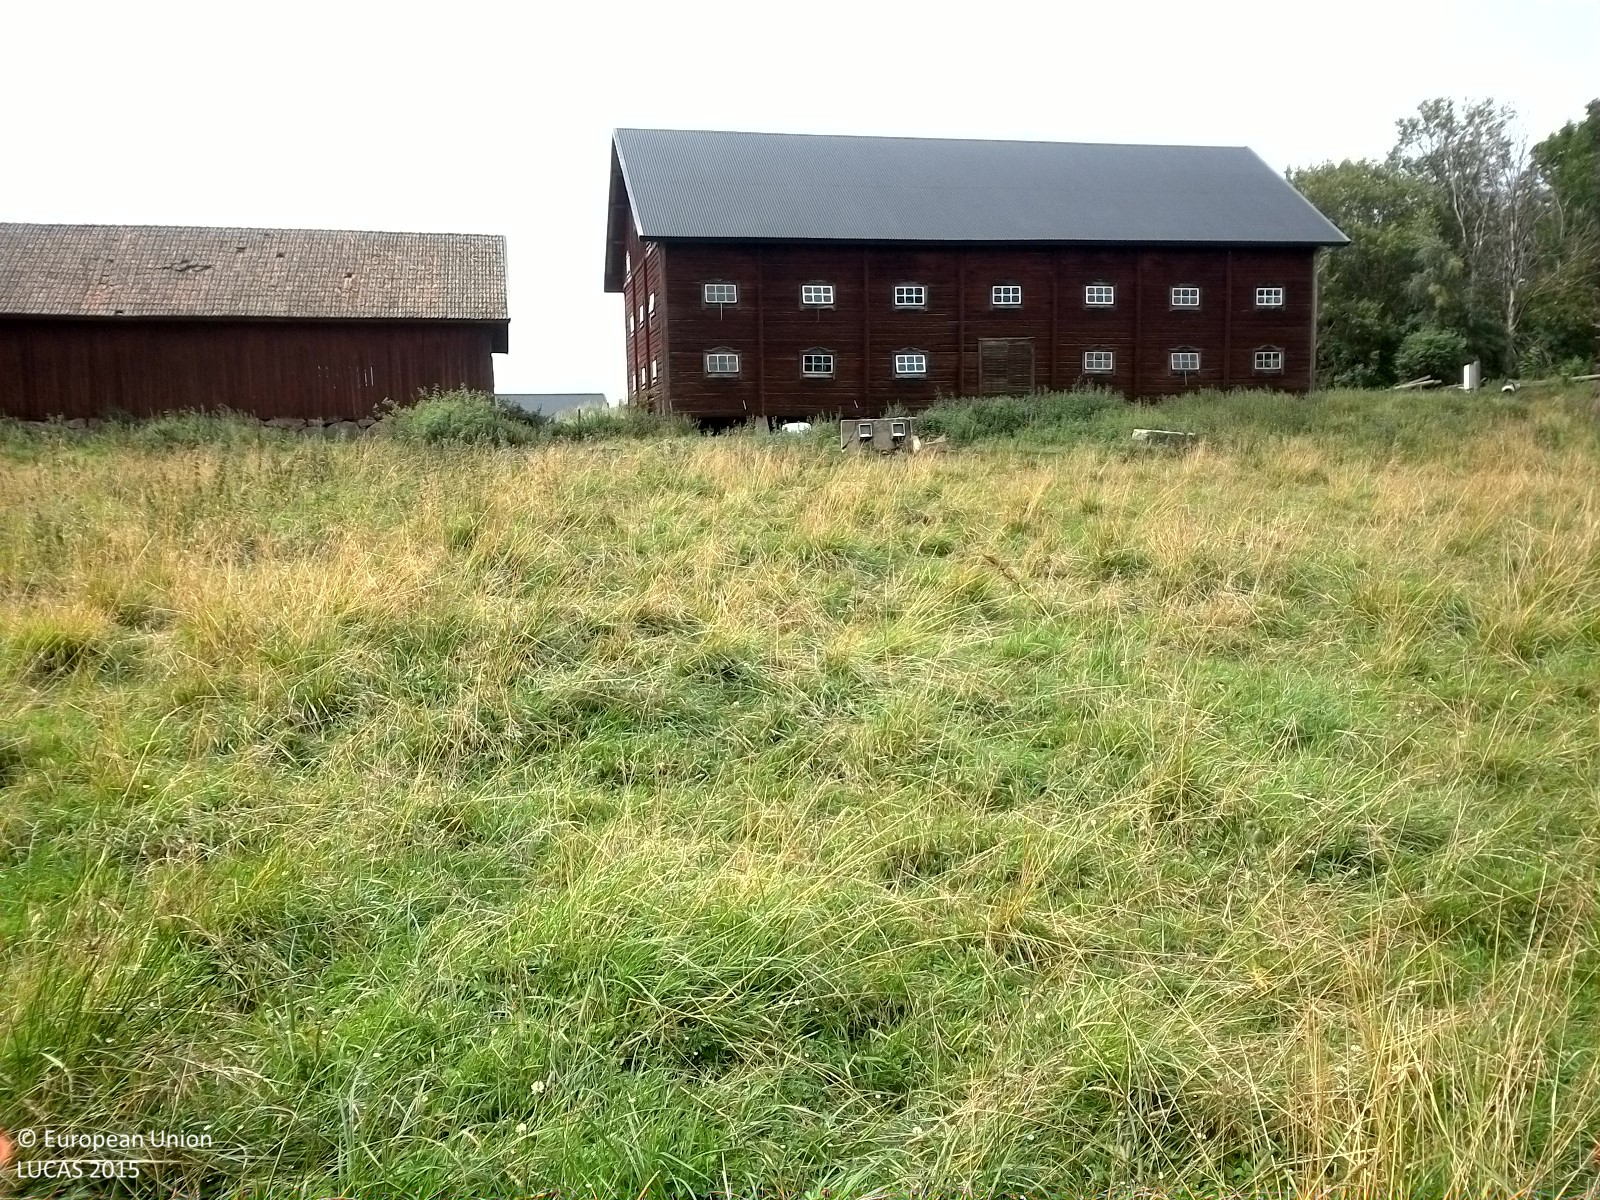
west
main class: Grassland
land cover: Grassland without tree/shrub cover
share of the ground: > 75 %
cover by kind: herbaceous plants 100 %
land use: Agriculture (excluding fallow land and kitchen gardens)
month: August
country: SE
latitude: 59.1204
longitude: 14.9356
